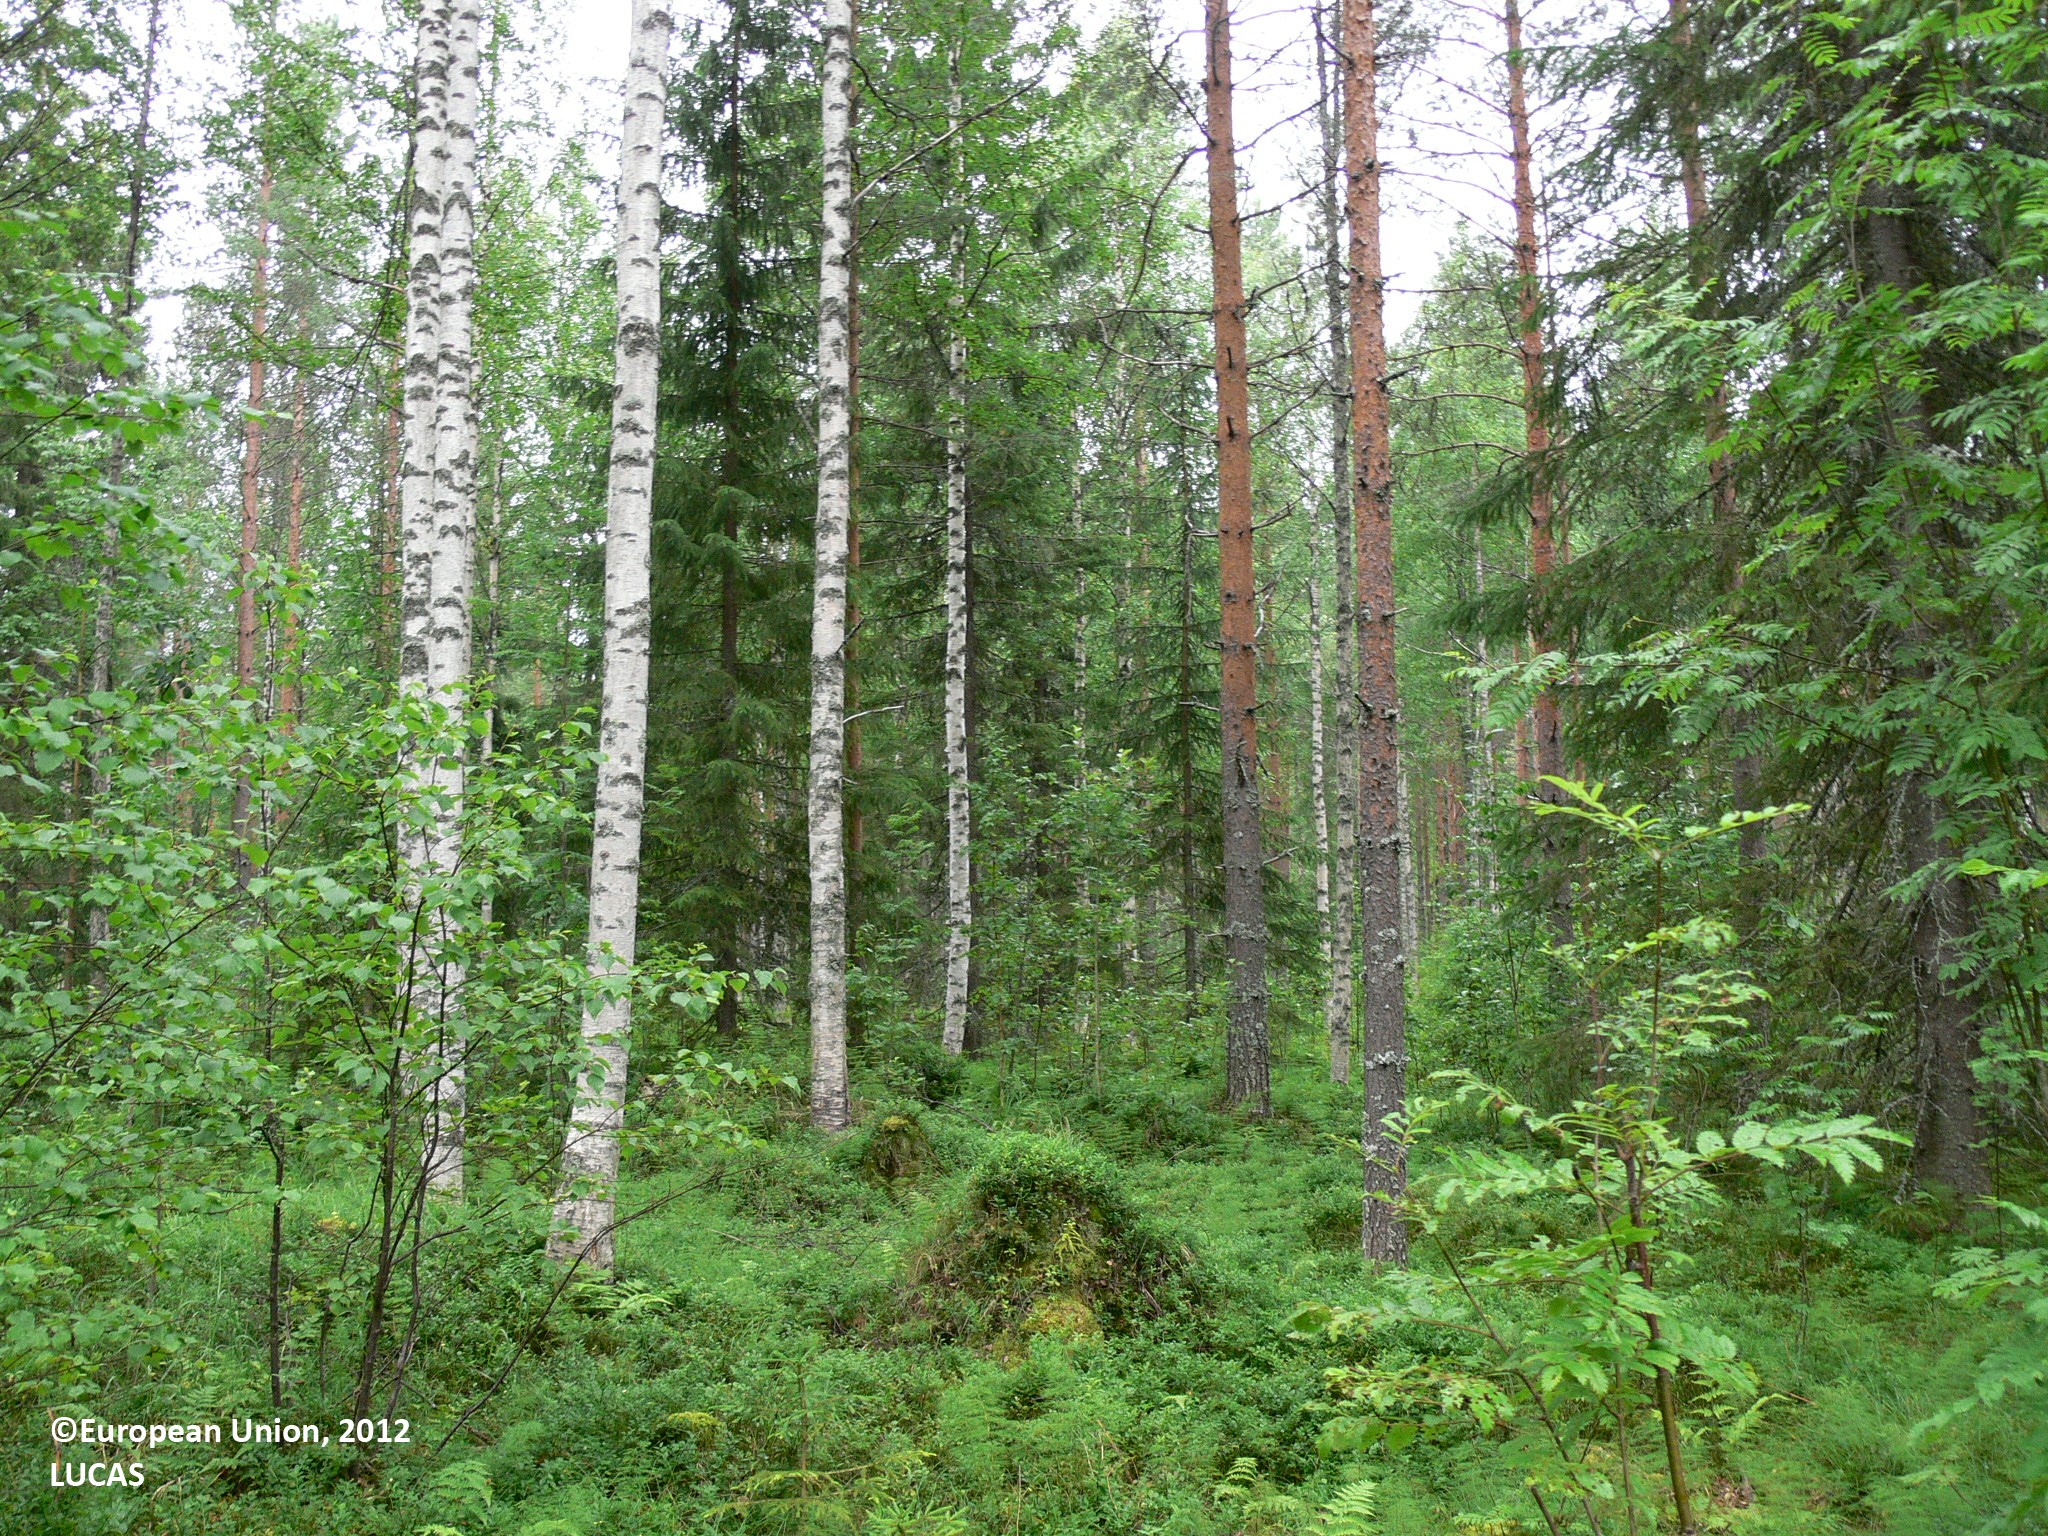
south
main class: Woodland
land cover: Other mixed woodland
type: boreal forest
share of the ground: > 75 %
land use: Forestry
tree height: > 5 m
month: July
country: FI
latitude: 63.2301
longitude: 30.8464
